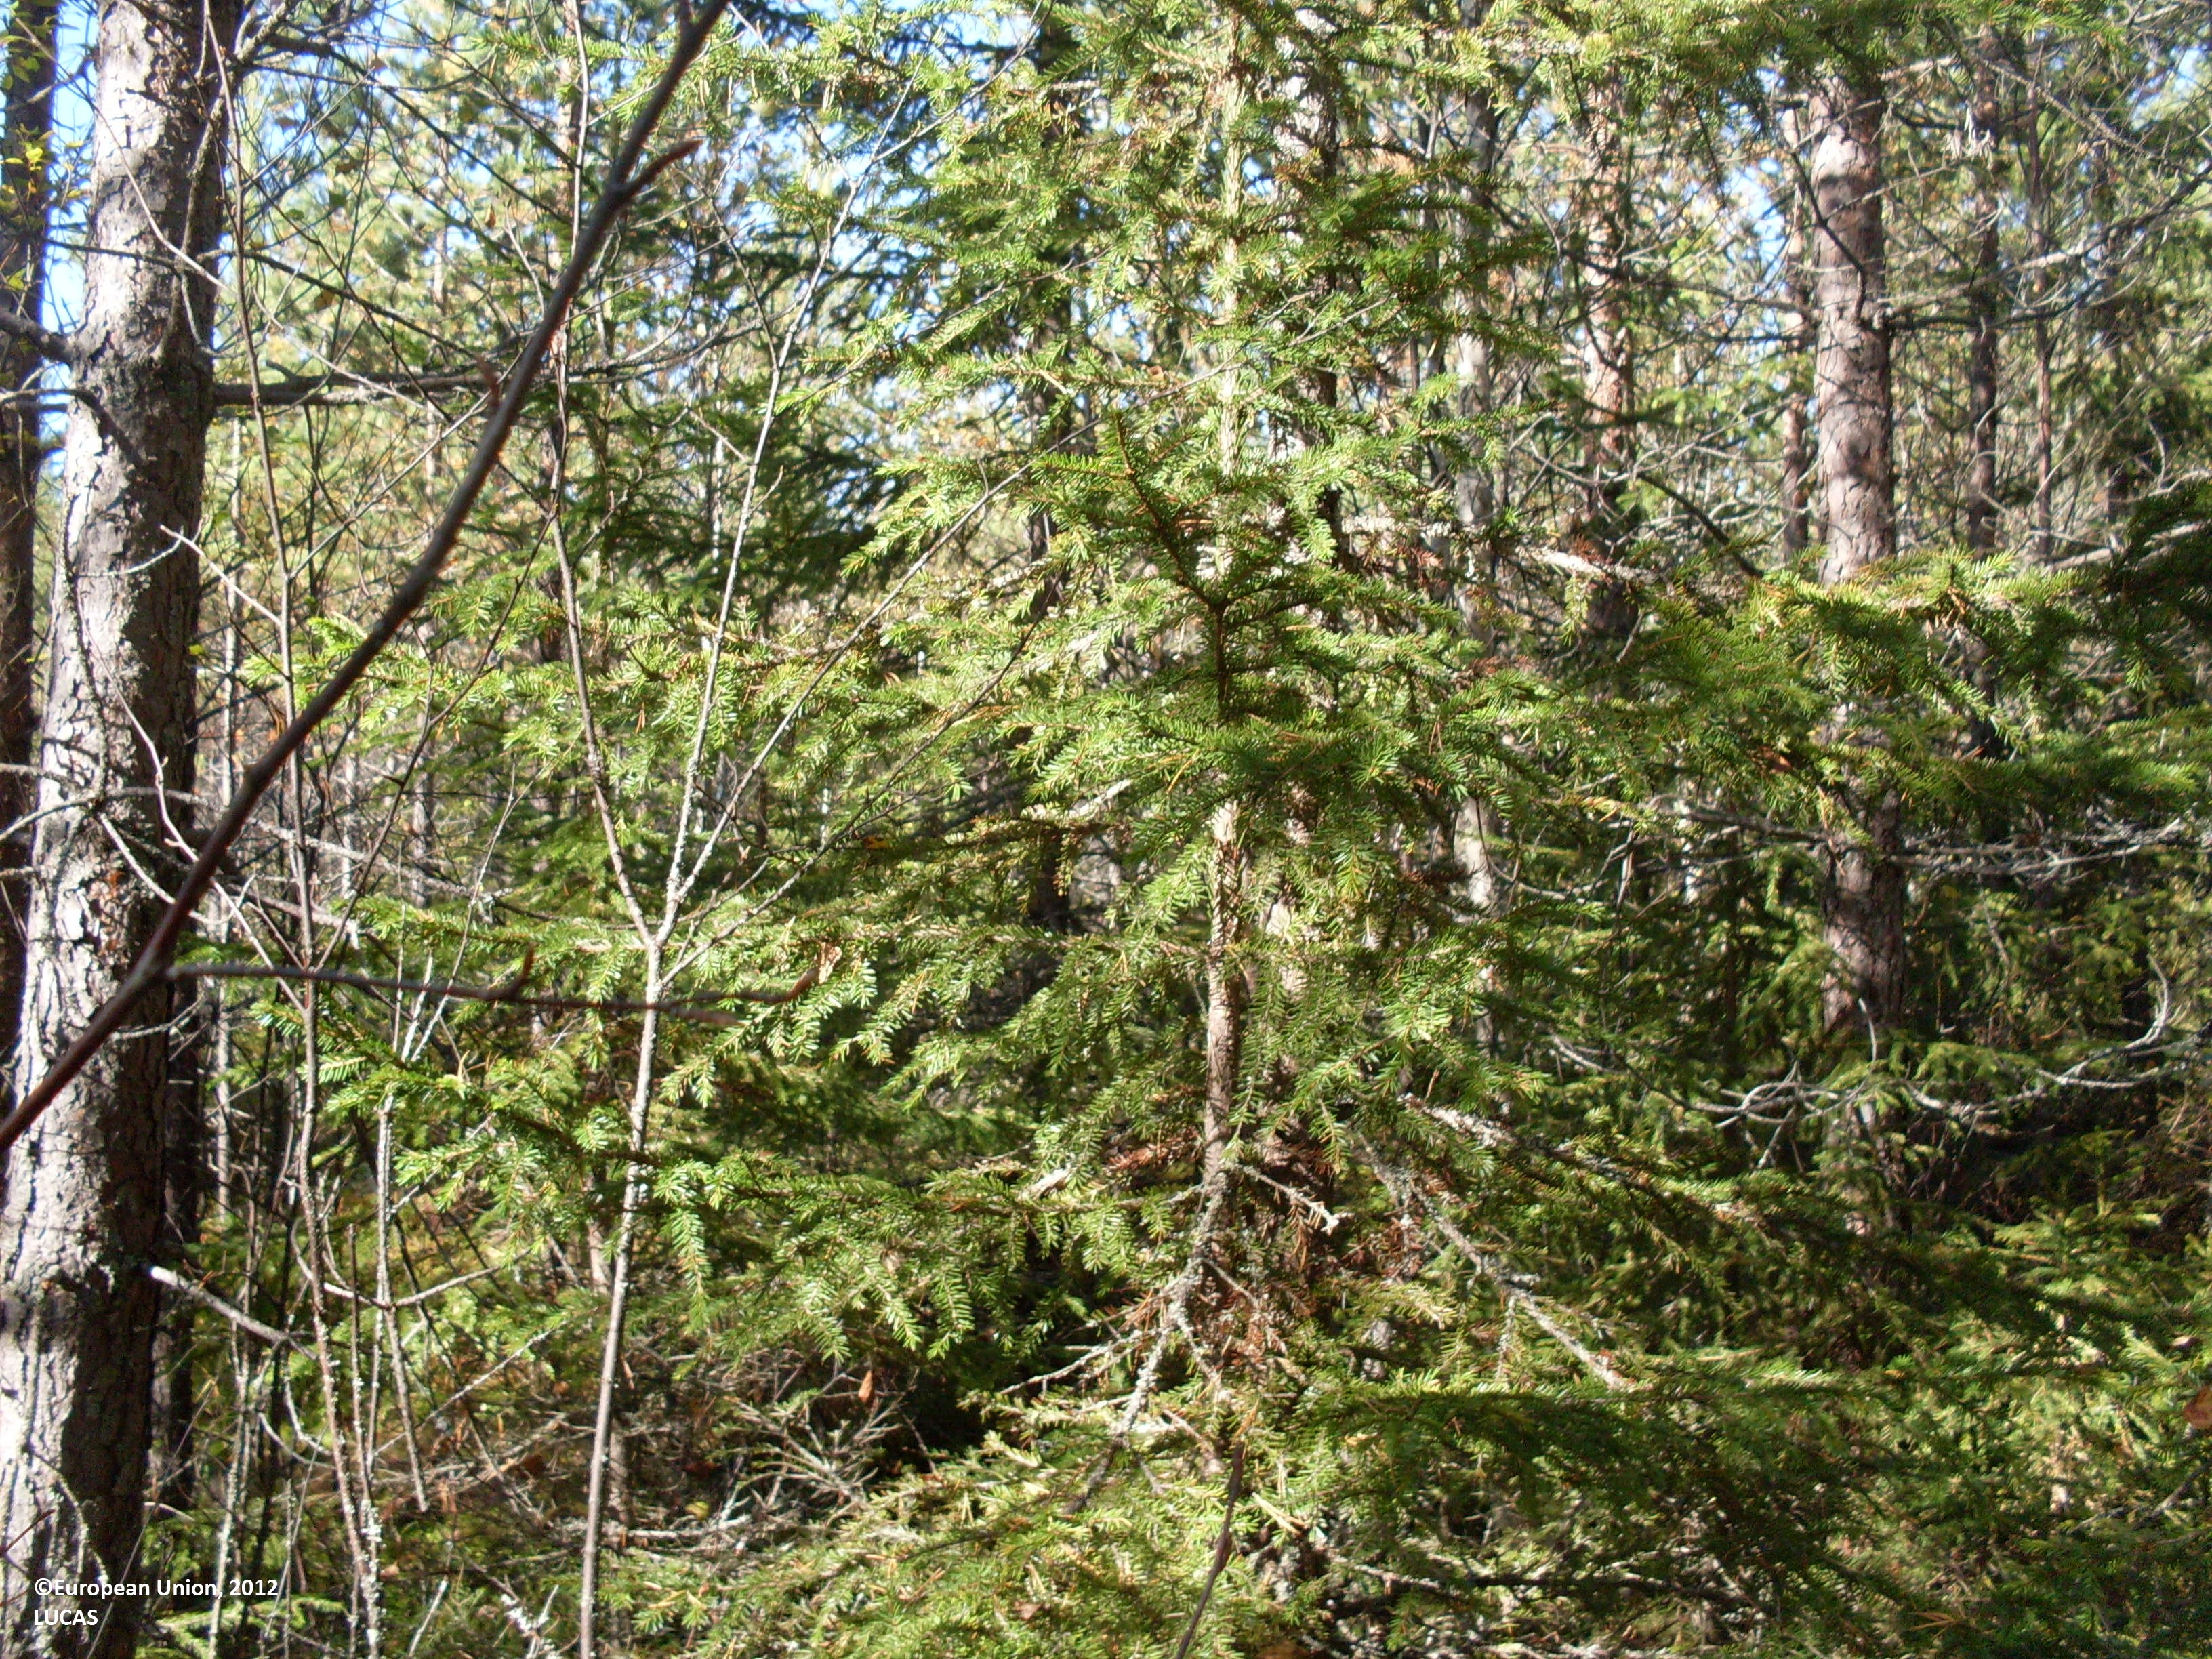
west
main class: Woodland
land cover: Pine dominated mixed woodland
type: boreal forest
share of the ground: > 75 %
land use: Forestry
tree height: > 5 m
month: September
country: FI
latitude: 64.3310
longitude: 28.5752
